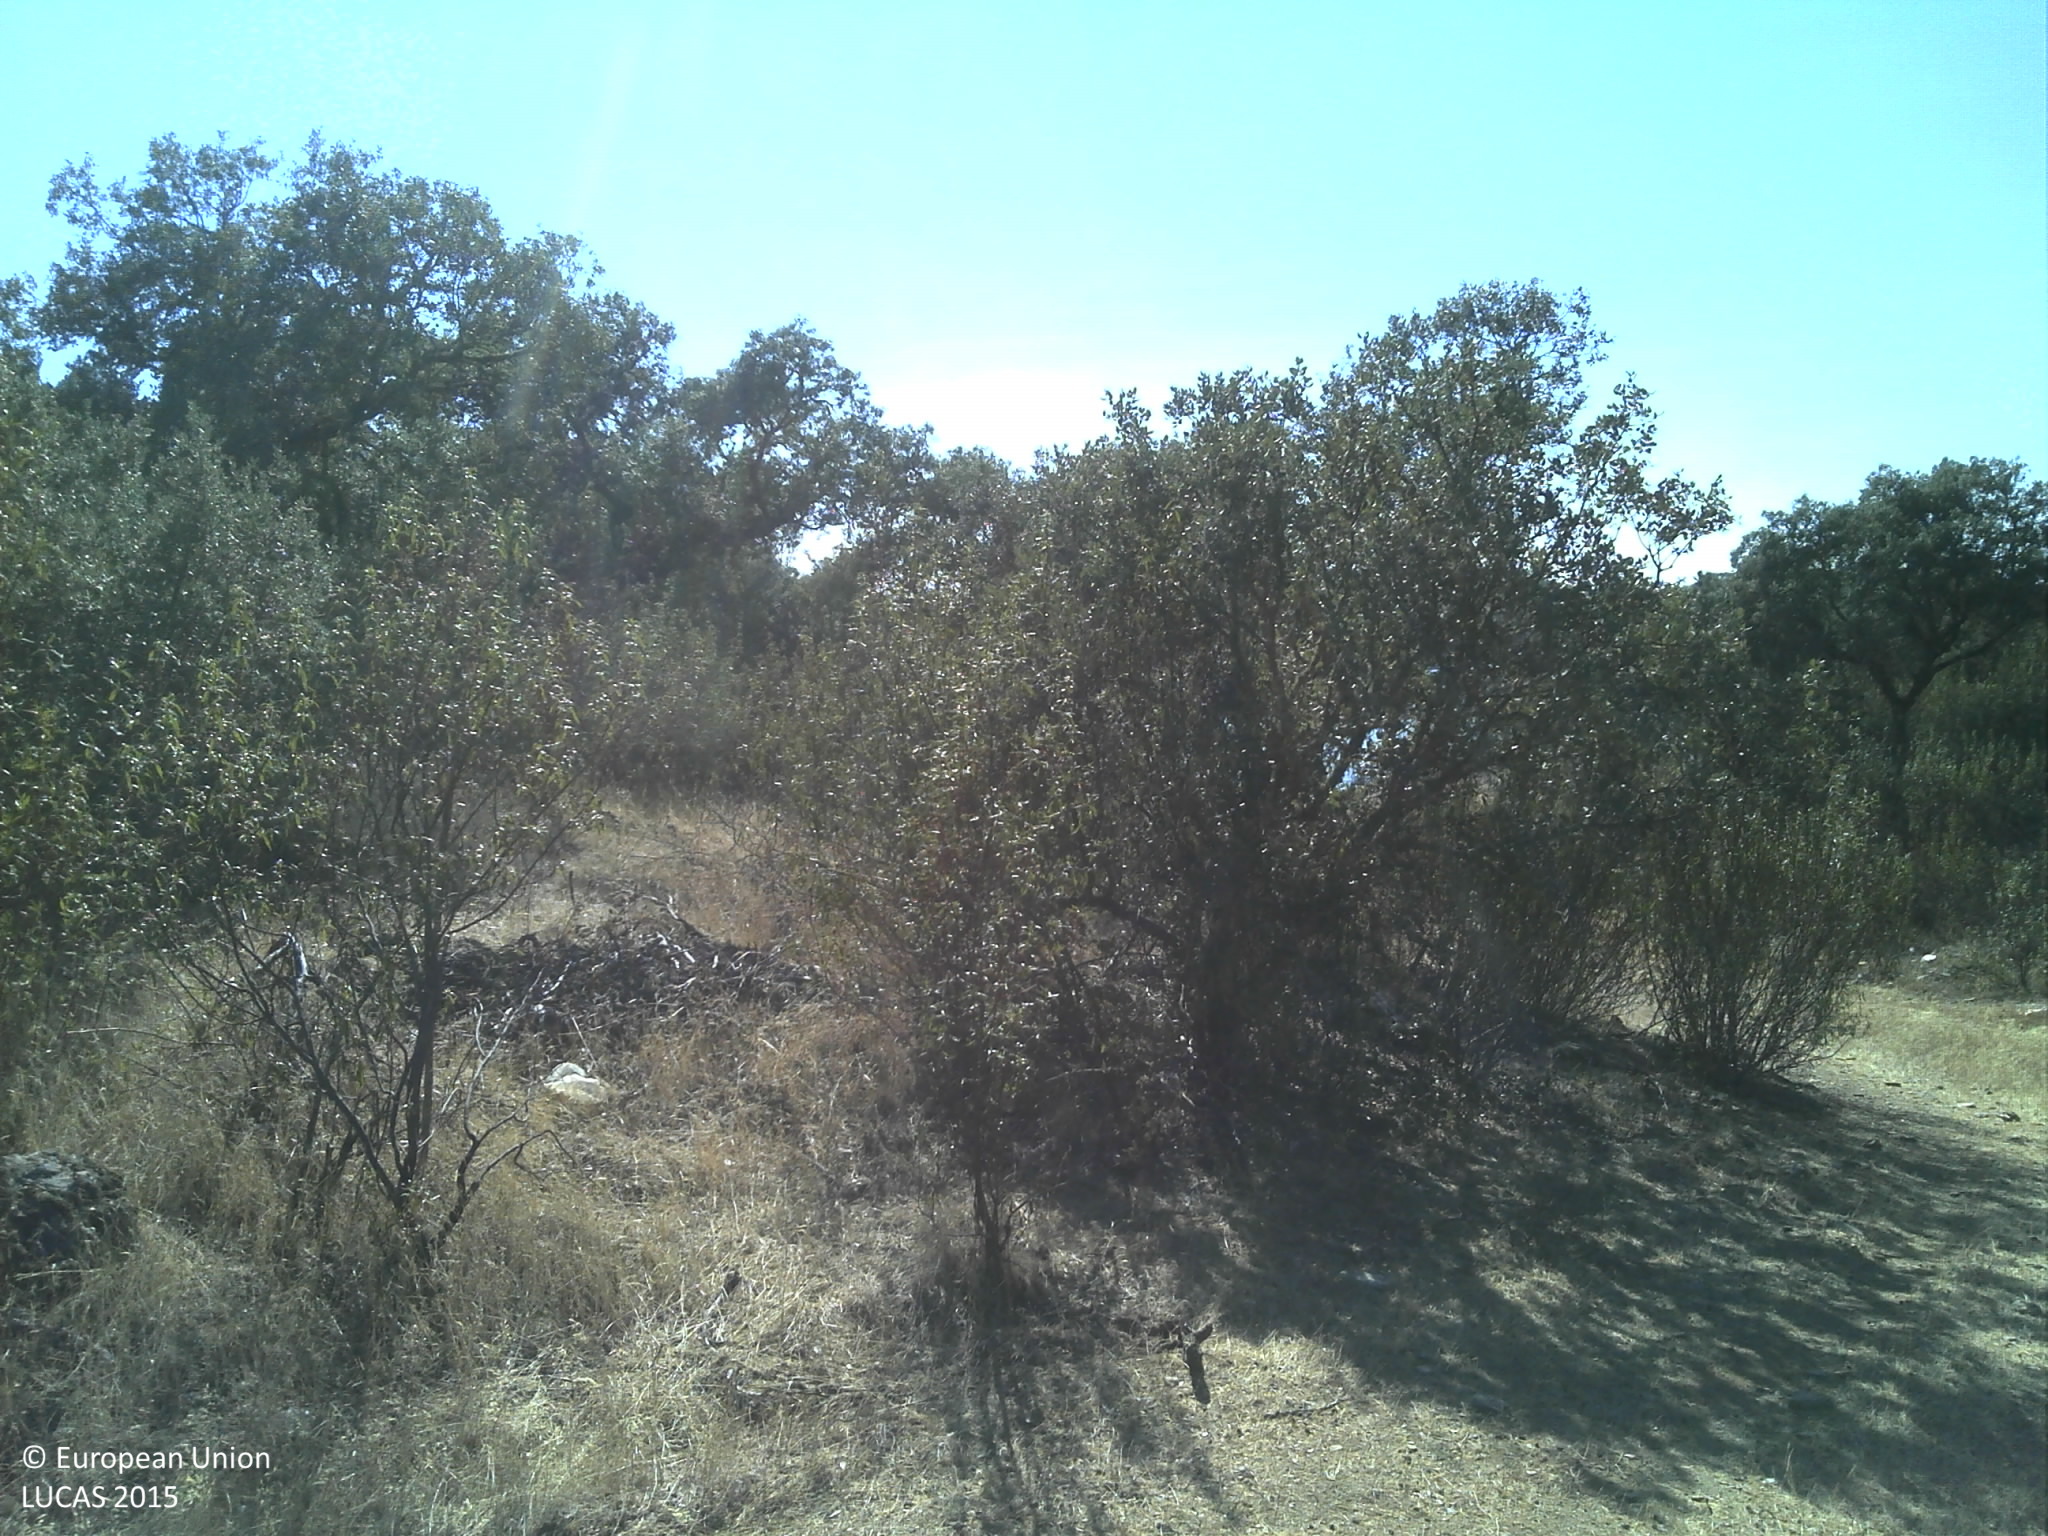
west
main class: Woodland
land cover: Broadleaved woodland
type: broadleaved evergreen forest
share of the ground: 10 - 25 %
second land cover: Grassland without tree/shrub cover
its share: 50 - 75 %
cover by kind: herbaceous plants 60 %, unconsolidated bare surface 25 %, broadleaved forest trees 10 %, shrubs 5 %
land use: Forestry
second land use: Agriculture (excluding fallow land and kitchen gardens)
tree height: > 5 m
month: July
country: PT
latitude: 38.5833
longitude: -7.3260
